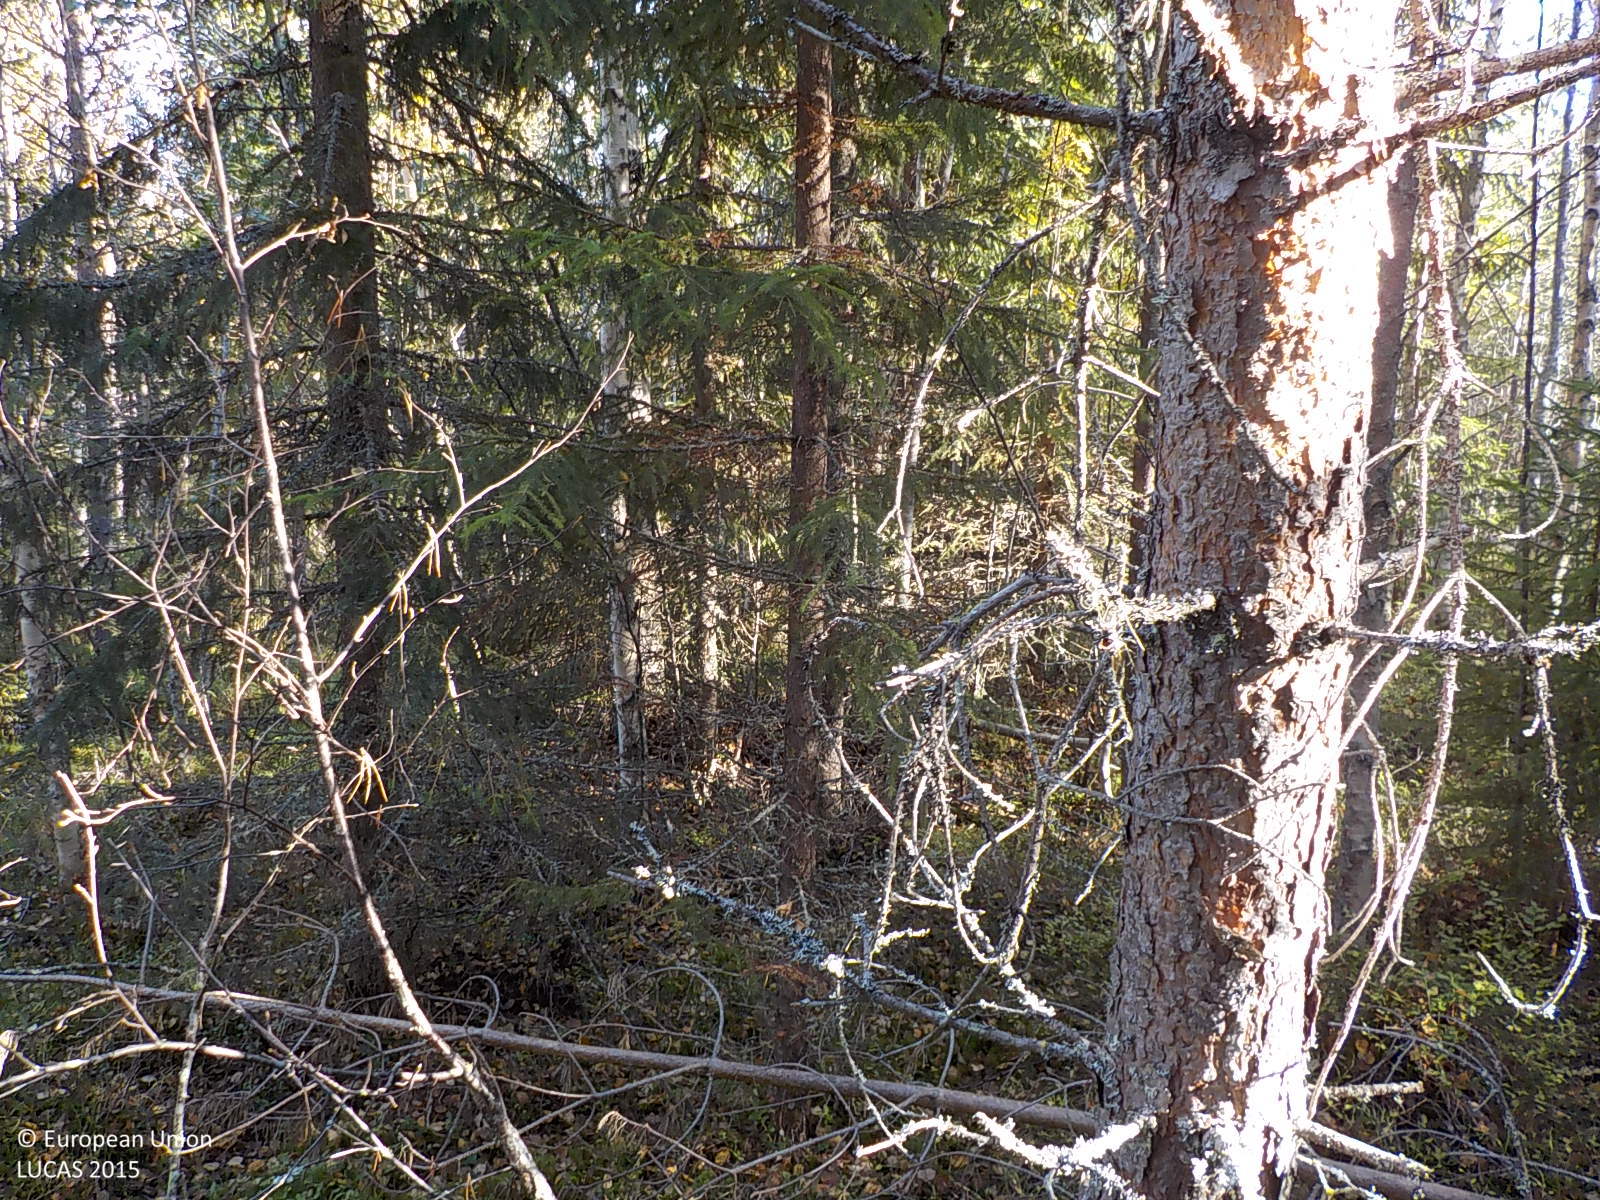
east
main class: Woodland
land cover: Other mixed woodland
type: boreal forest
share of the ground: > 75 %
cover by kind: coniferous forest trees 45 %, broadleaved forest trees 35 %, shrubs 10 %, herbaceous plants 10 %
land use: Forestry
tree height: > 5 m
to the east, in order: Other mixed woodland; Tracks; Ditches and canals; Spruce dominated mixed woodland; Pine dominated mixed woodland; Ditches and canals; Pine dominated mixed woodland
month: September
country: SE
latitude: 63.4363
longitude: 17.2097
